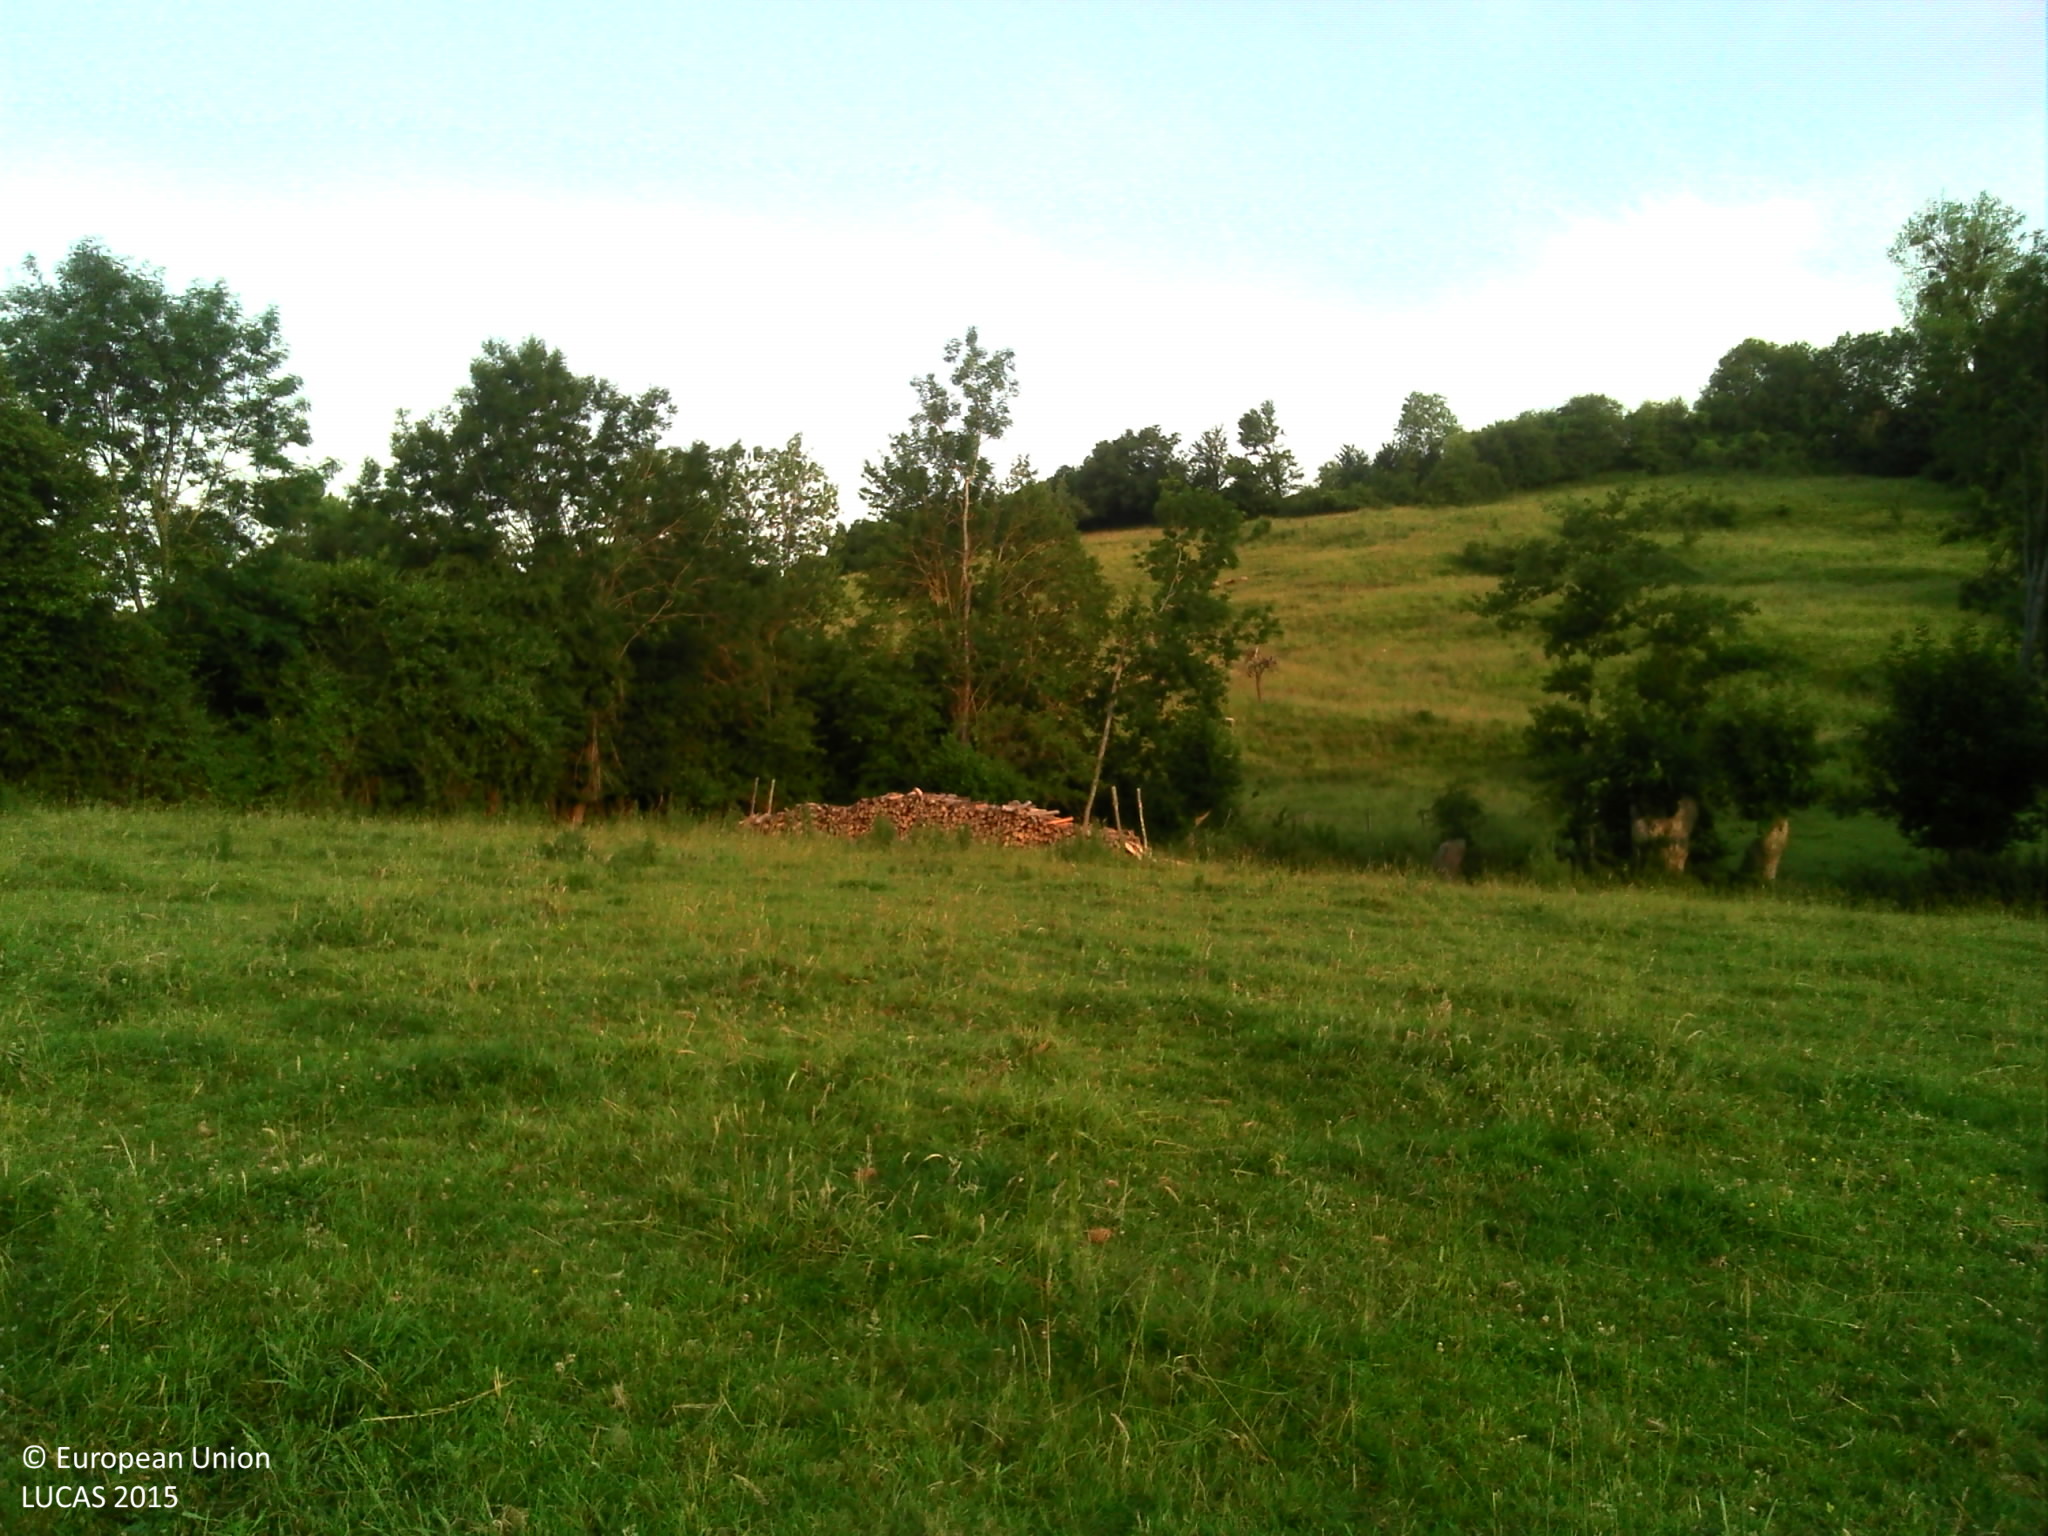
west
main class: Grassland
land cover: Grassland without tree/shrub cover
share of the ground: > 75 %
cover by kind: herbaceous plants 100 %
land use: Agriculture (excluding fallow land and kitchen gardens)
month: July
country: FR
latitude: 49.0308
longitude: 0.1366
